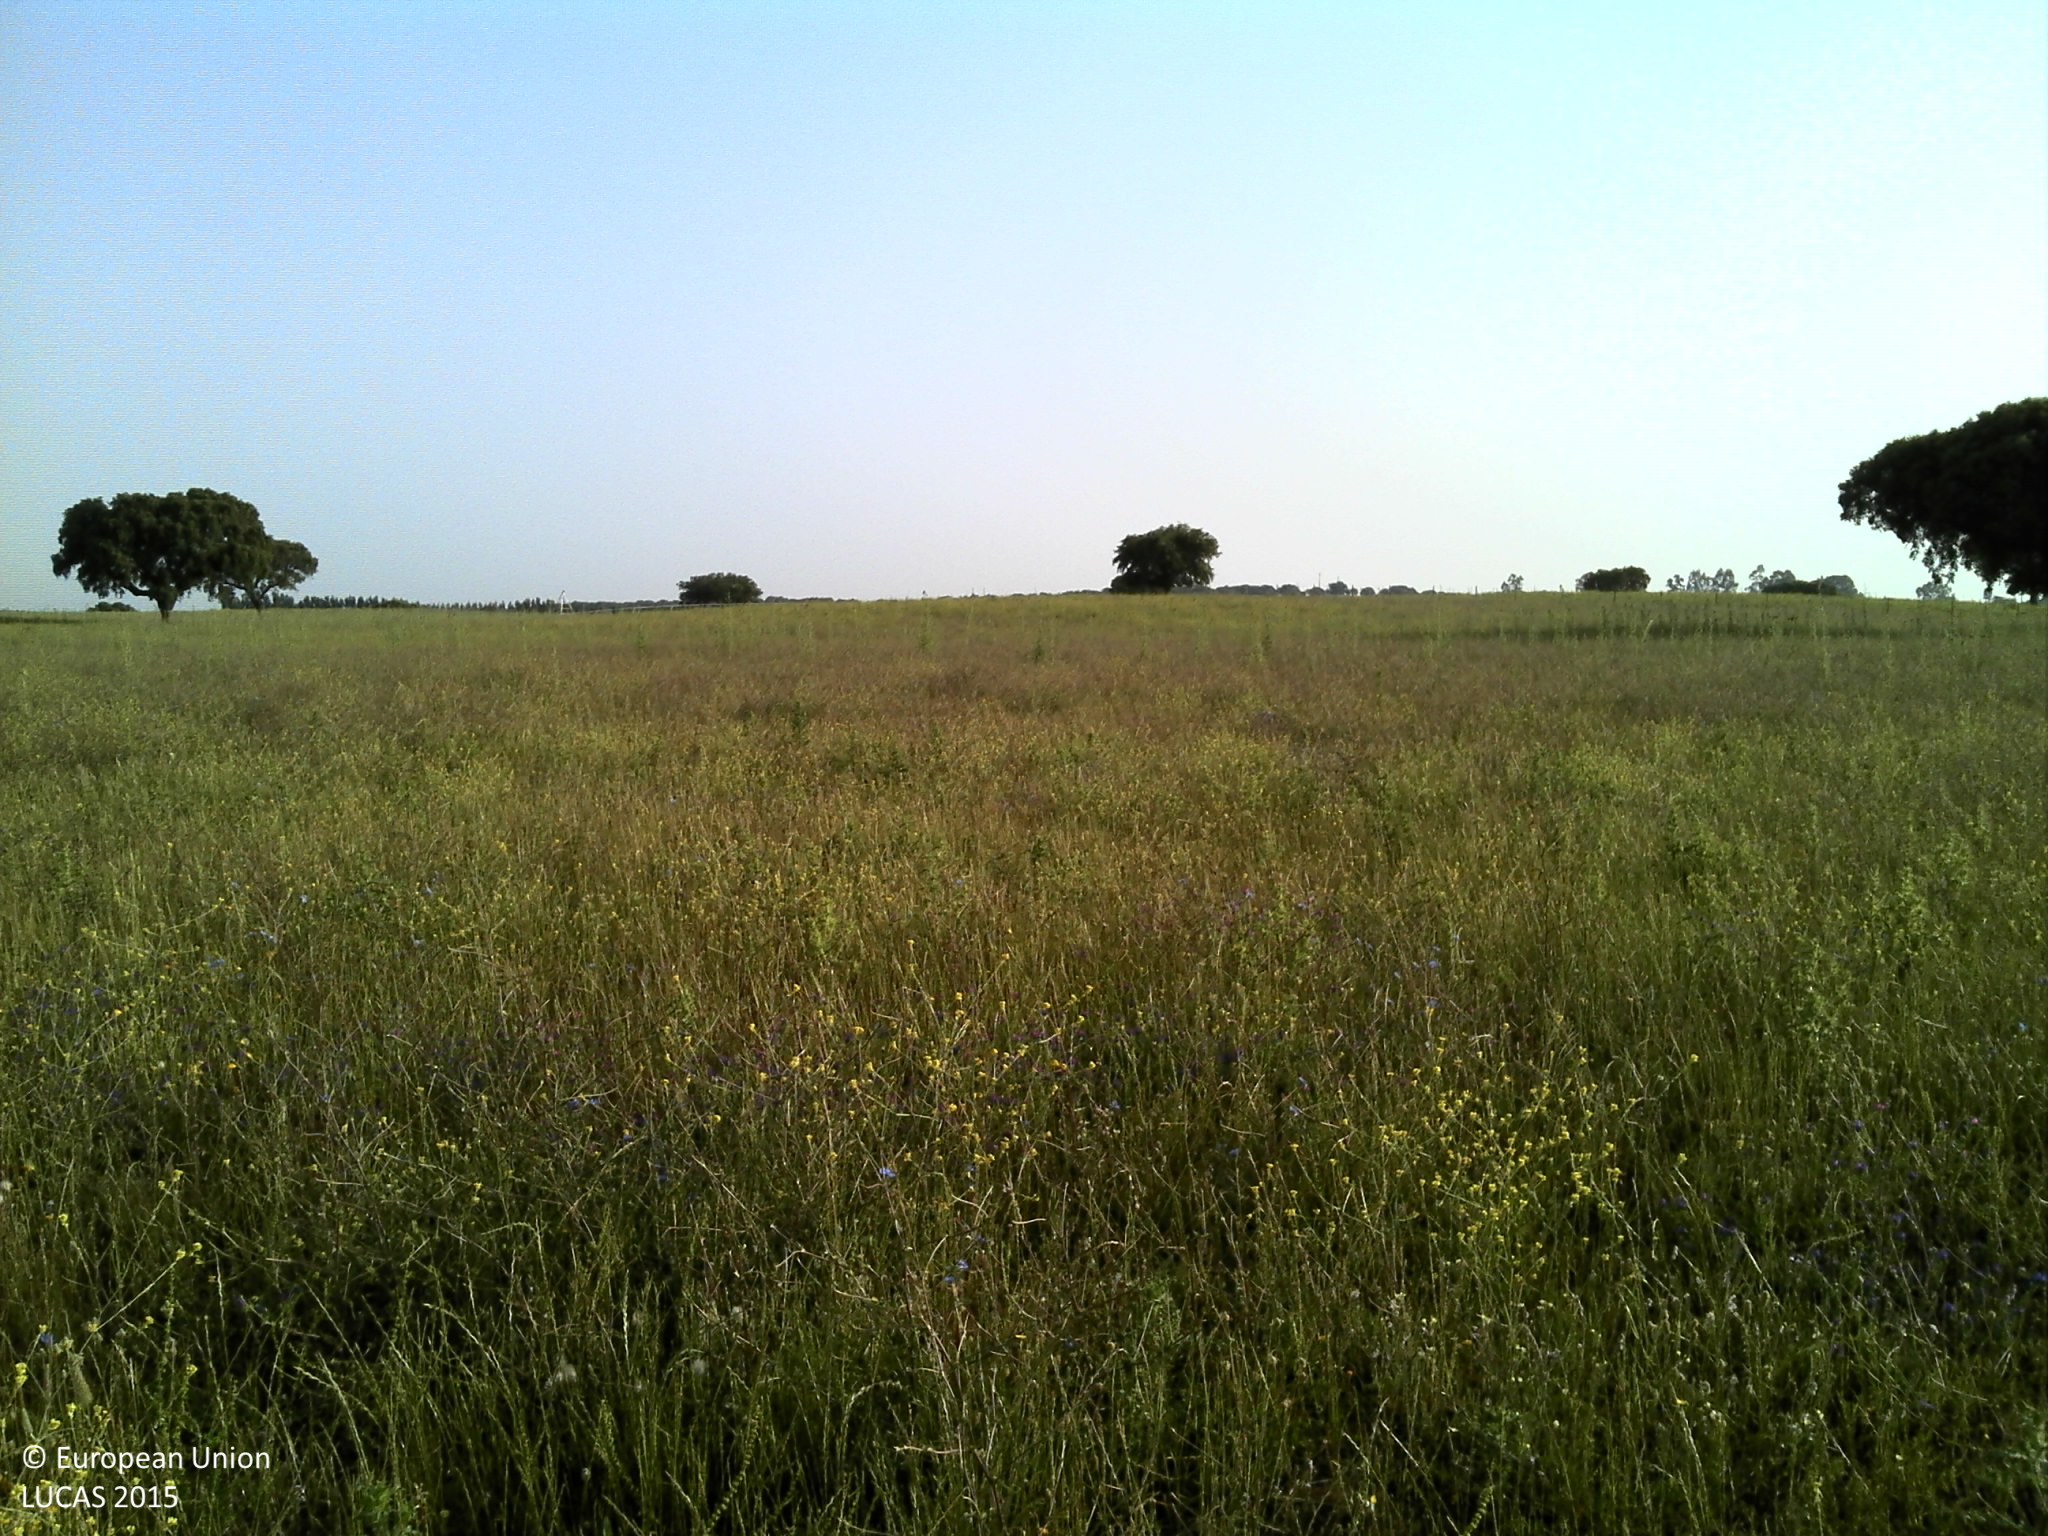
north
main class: Grassland
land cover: Grassland without tree/shrub cover
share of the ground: 50 - 75 %
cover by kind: herbaceous plants 75 %, unconsolidated bare surface 25 %
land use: Agriculture (excluding fallow land and kitchen gardens)
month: May
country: PT
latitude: 39.0360
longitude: -7.8730
